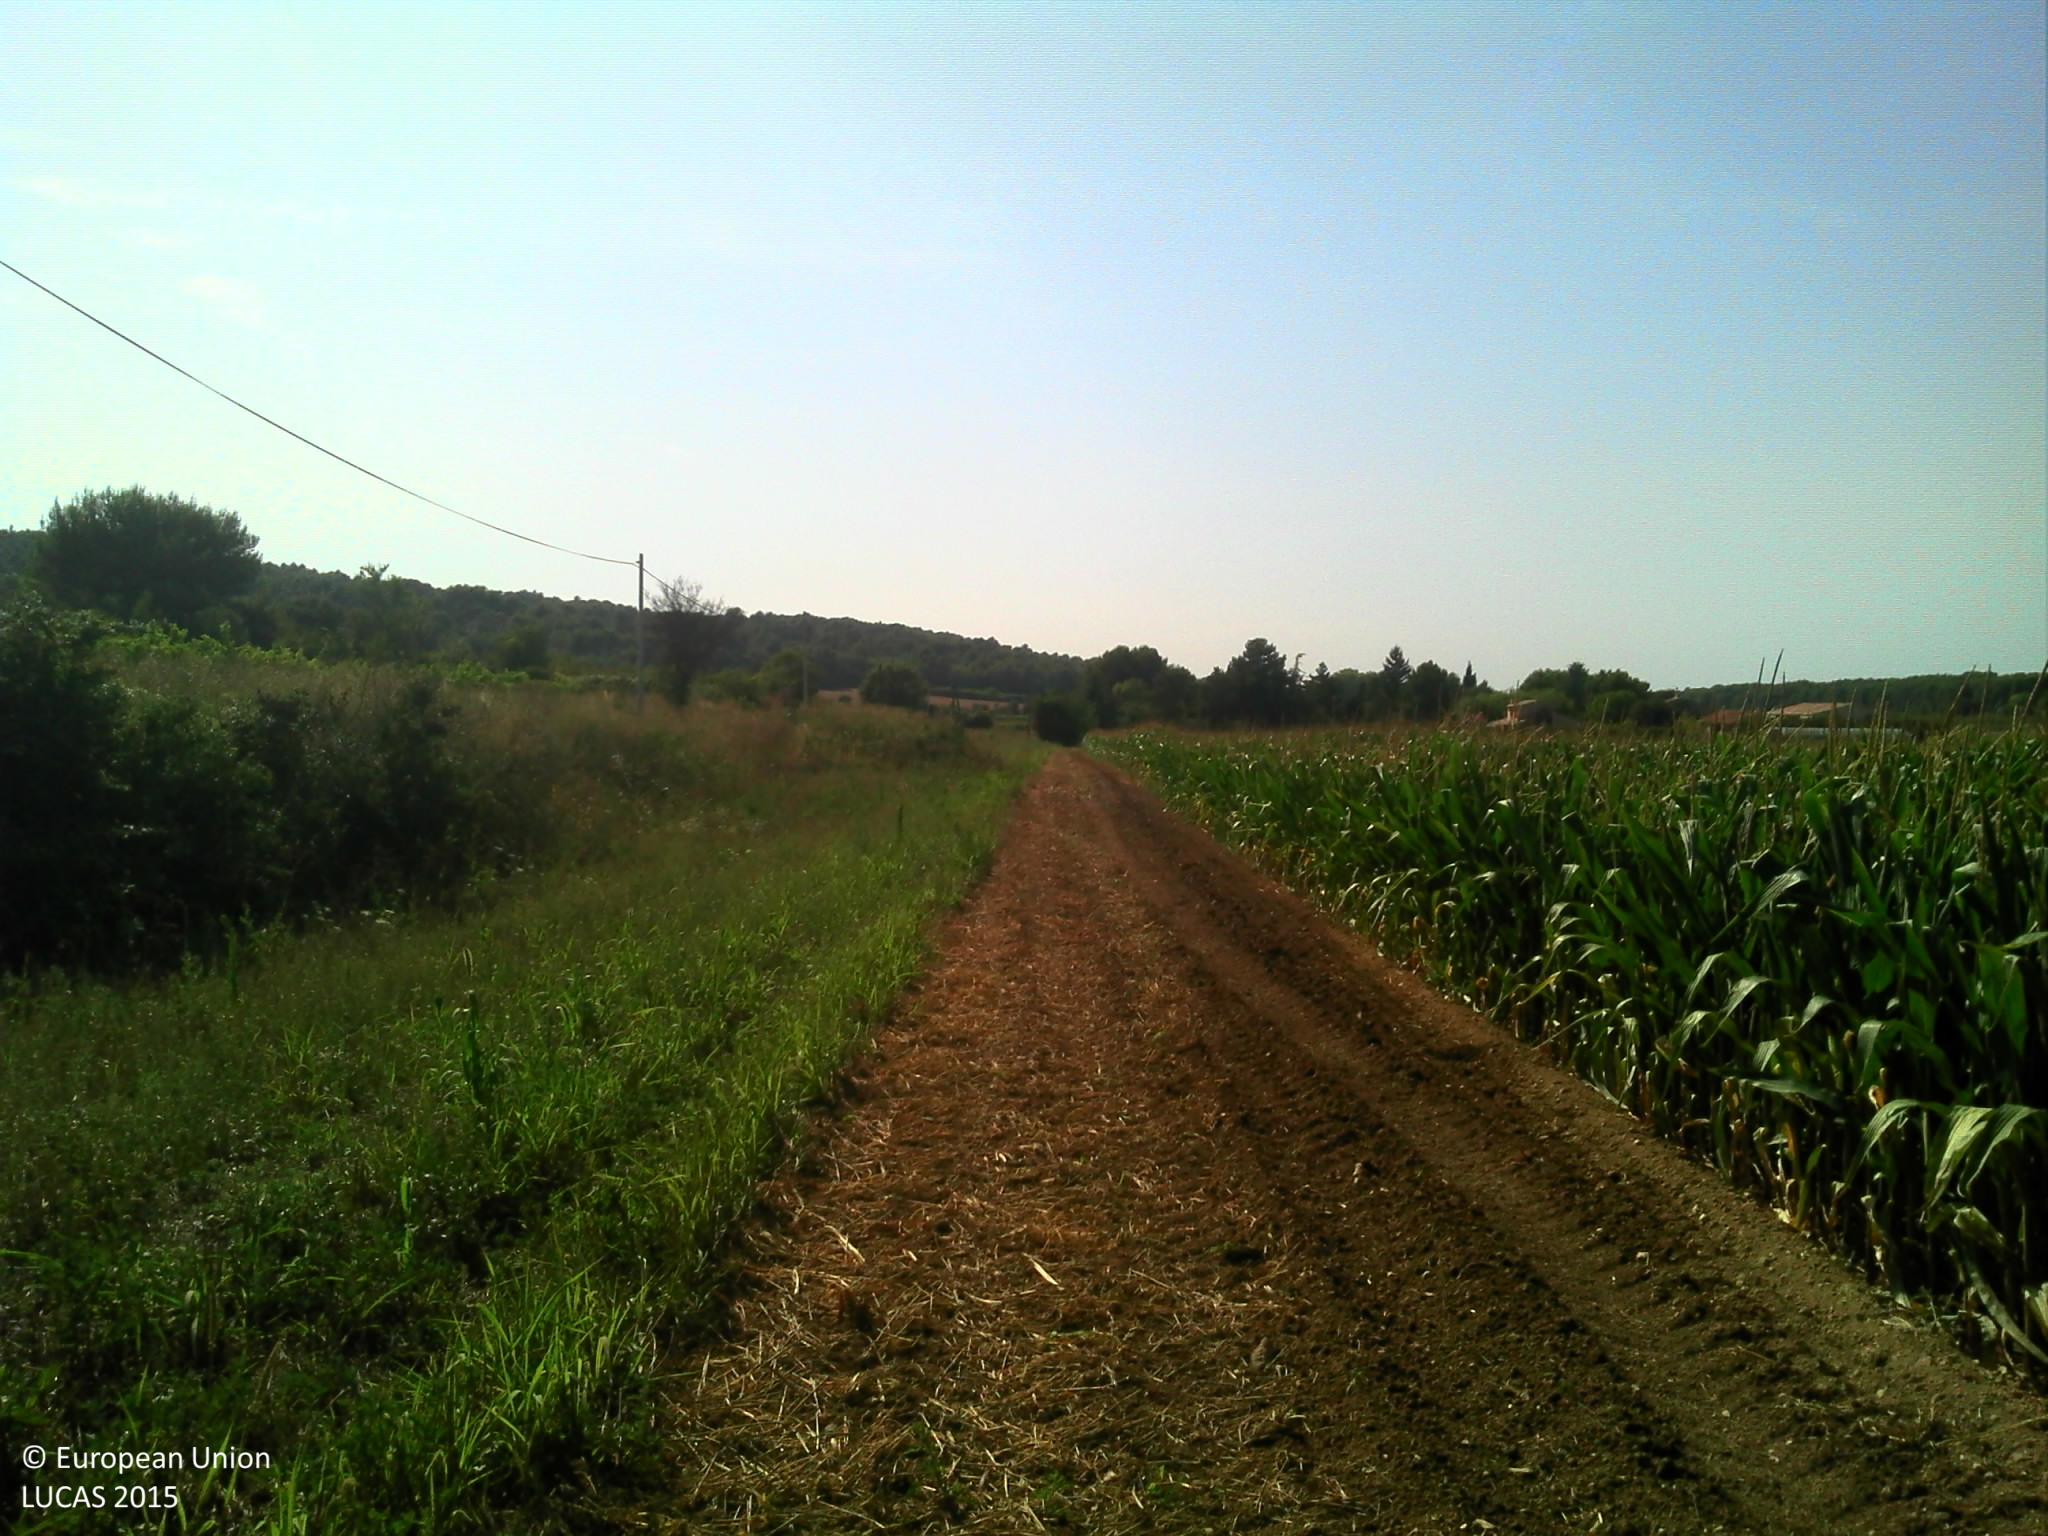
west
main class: Cropland
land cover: Maize
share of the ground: > 75 %
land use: Agriculture (excluding fallow land and kitchen gardens)
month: August
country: FR
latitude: 43.5774
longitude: 5.3411
